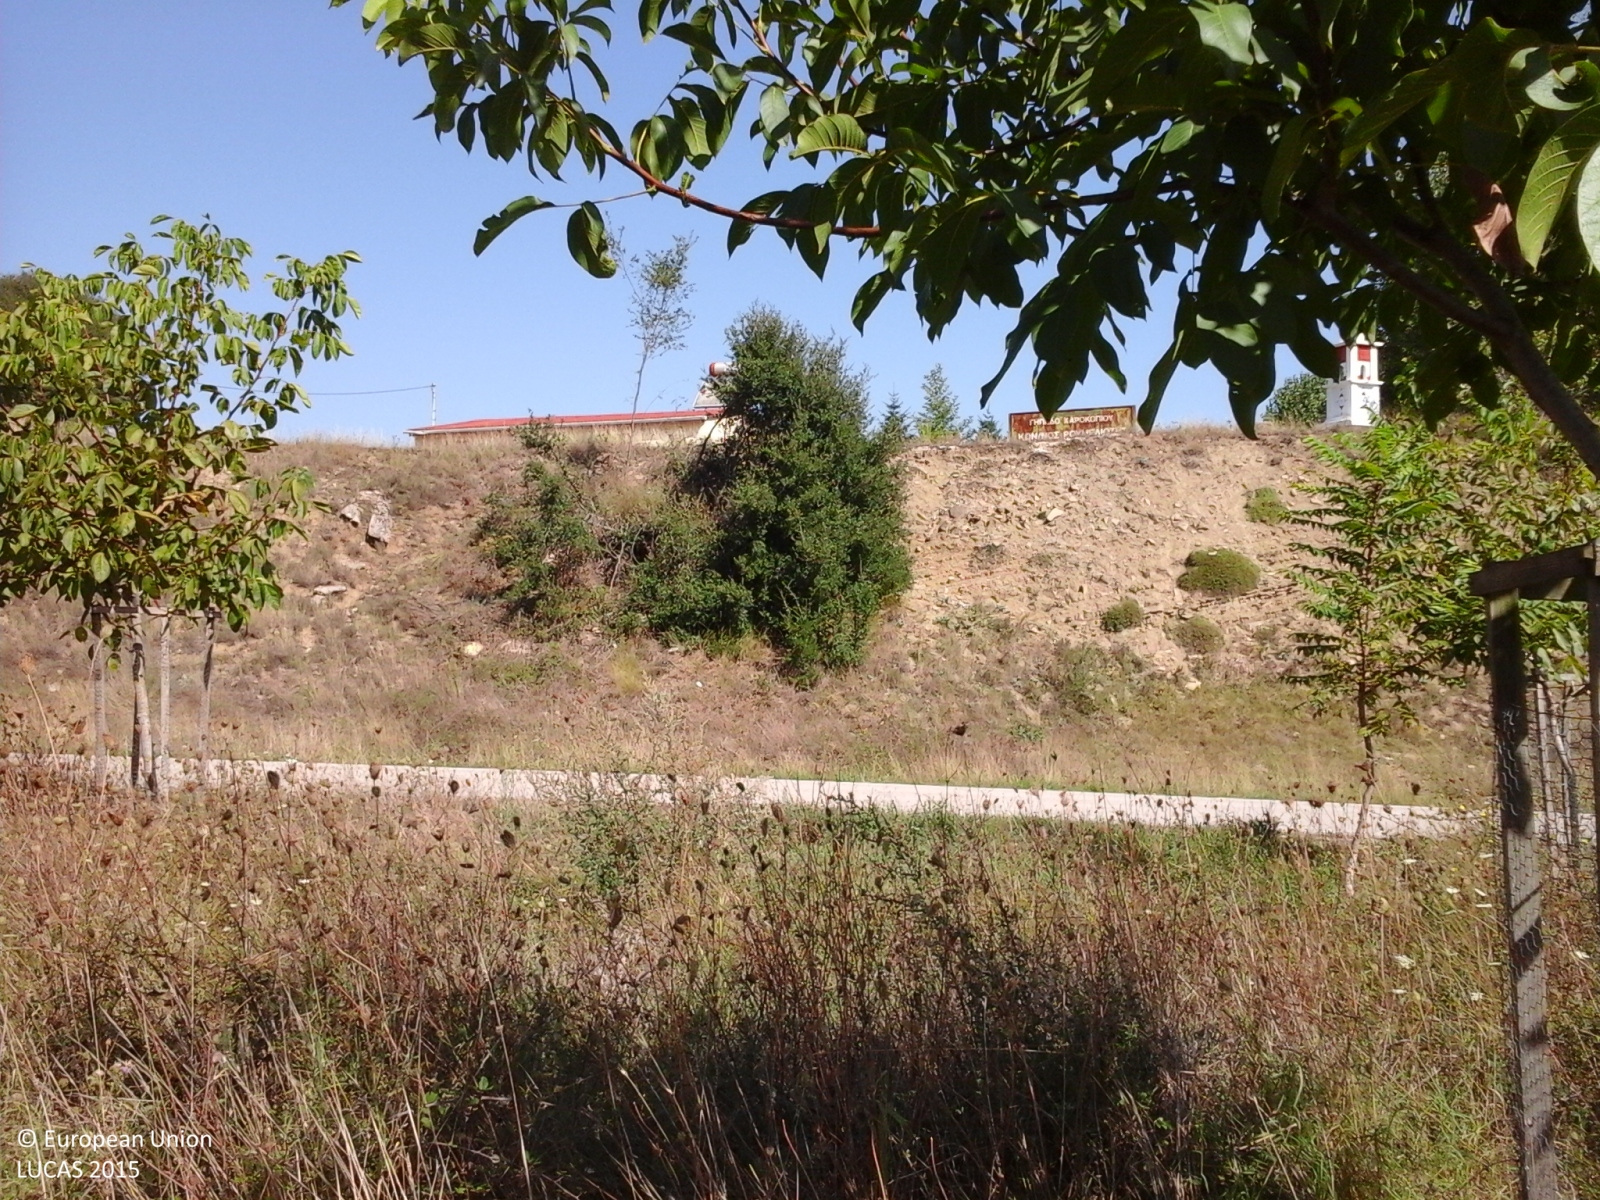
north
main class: Woodland
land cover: Broadleaved woodland
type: broadleaved evergreen forest
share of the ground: > 75 %
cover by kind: broadleaved forest trees 75 %, shrubs 10 %, unconsolidated bare surface 10 %, herbaceous plants 5 %
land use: Semi-natural and natural areas not in use
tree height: < 5 m
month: September
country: GR
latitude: 39.5788
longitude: 20.9566
